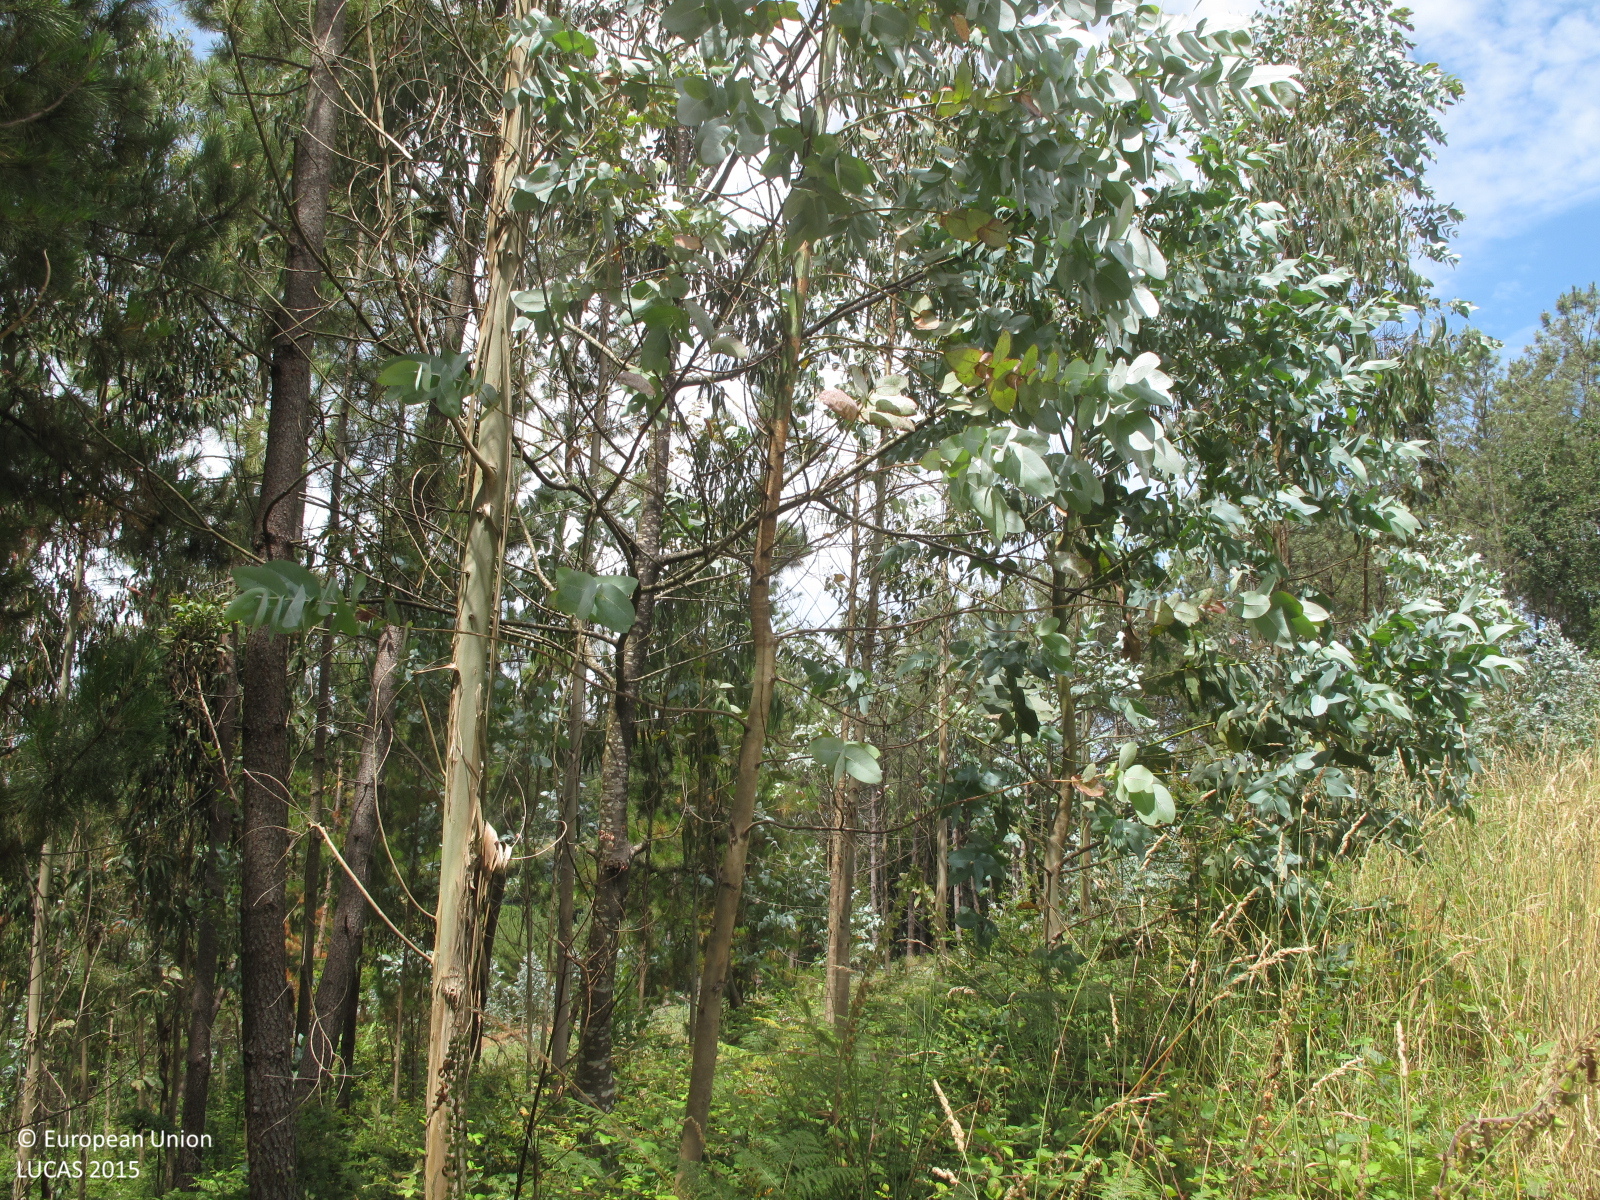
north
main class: Woodland
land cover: Pine dominated mixed woodland
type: coniferous forest of the mediterranean region
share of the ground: > 75 %
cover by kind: coniferous forest trees 50 %, broadleaved forest trees 30 %, shrubs 20 %
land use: Forestry
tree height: > 5 m
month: July
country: ES
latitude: 43.1637
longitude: -8.6217
